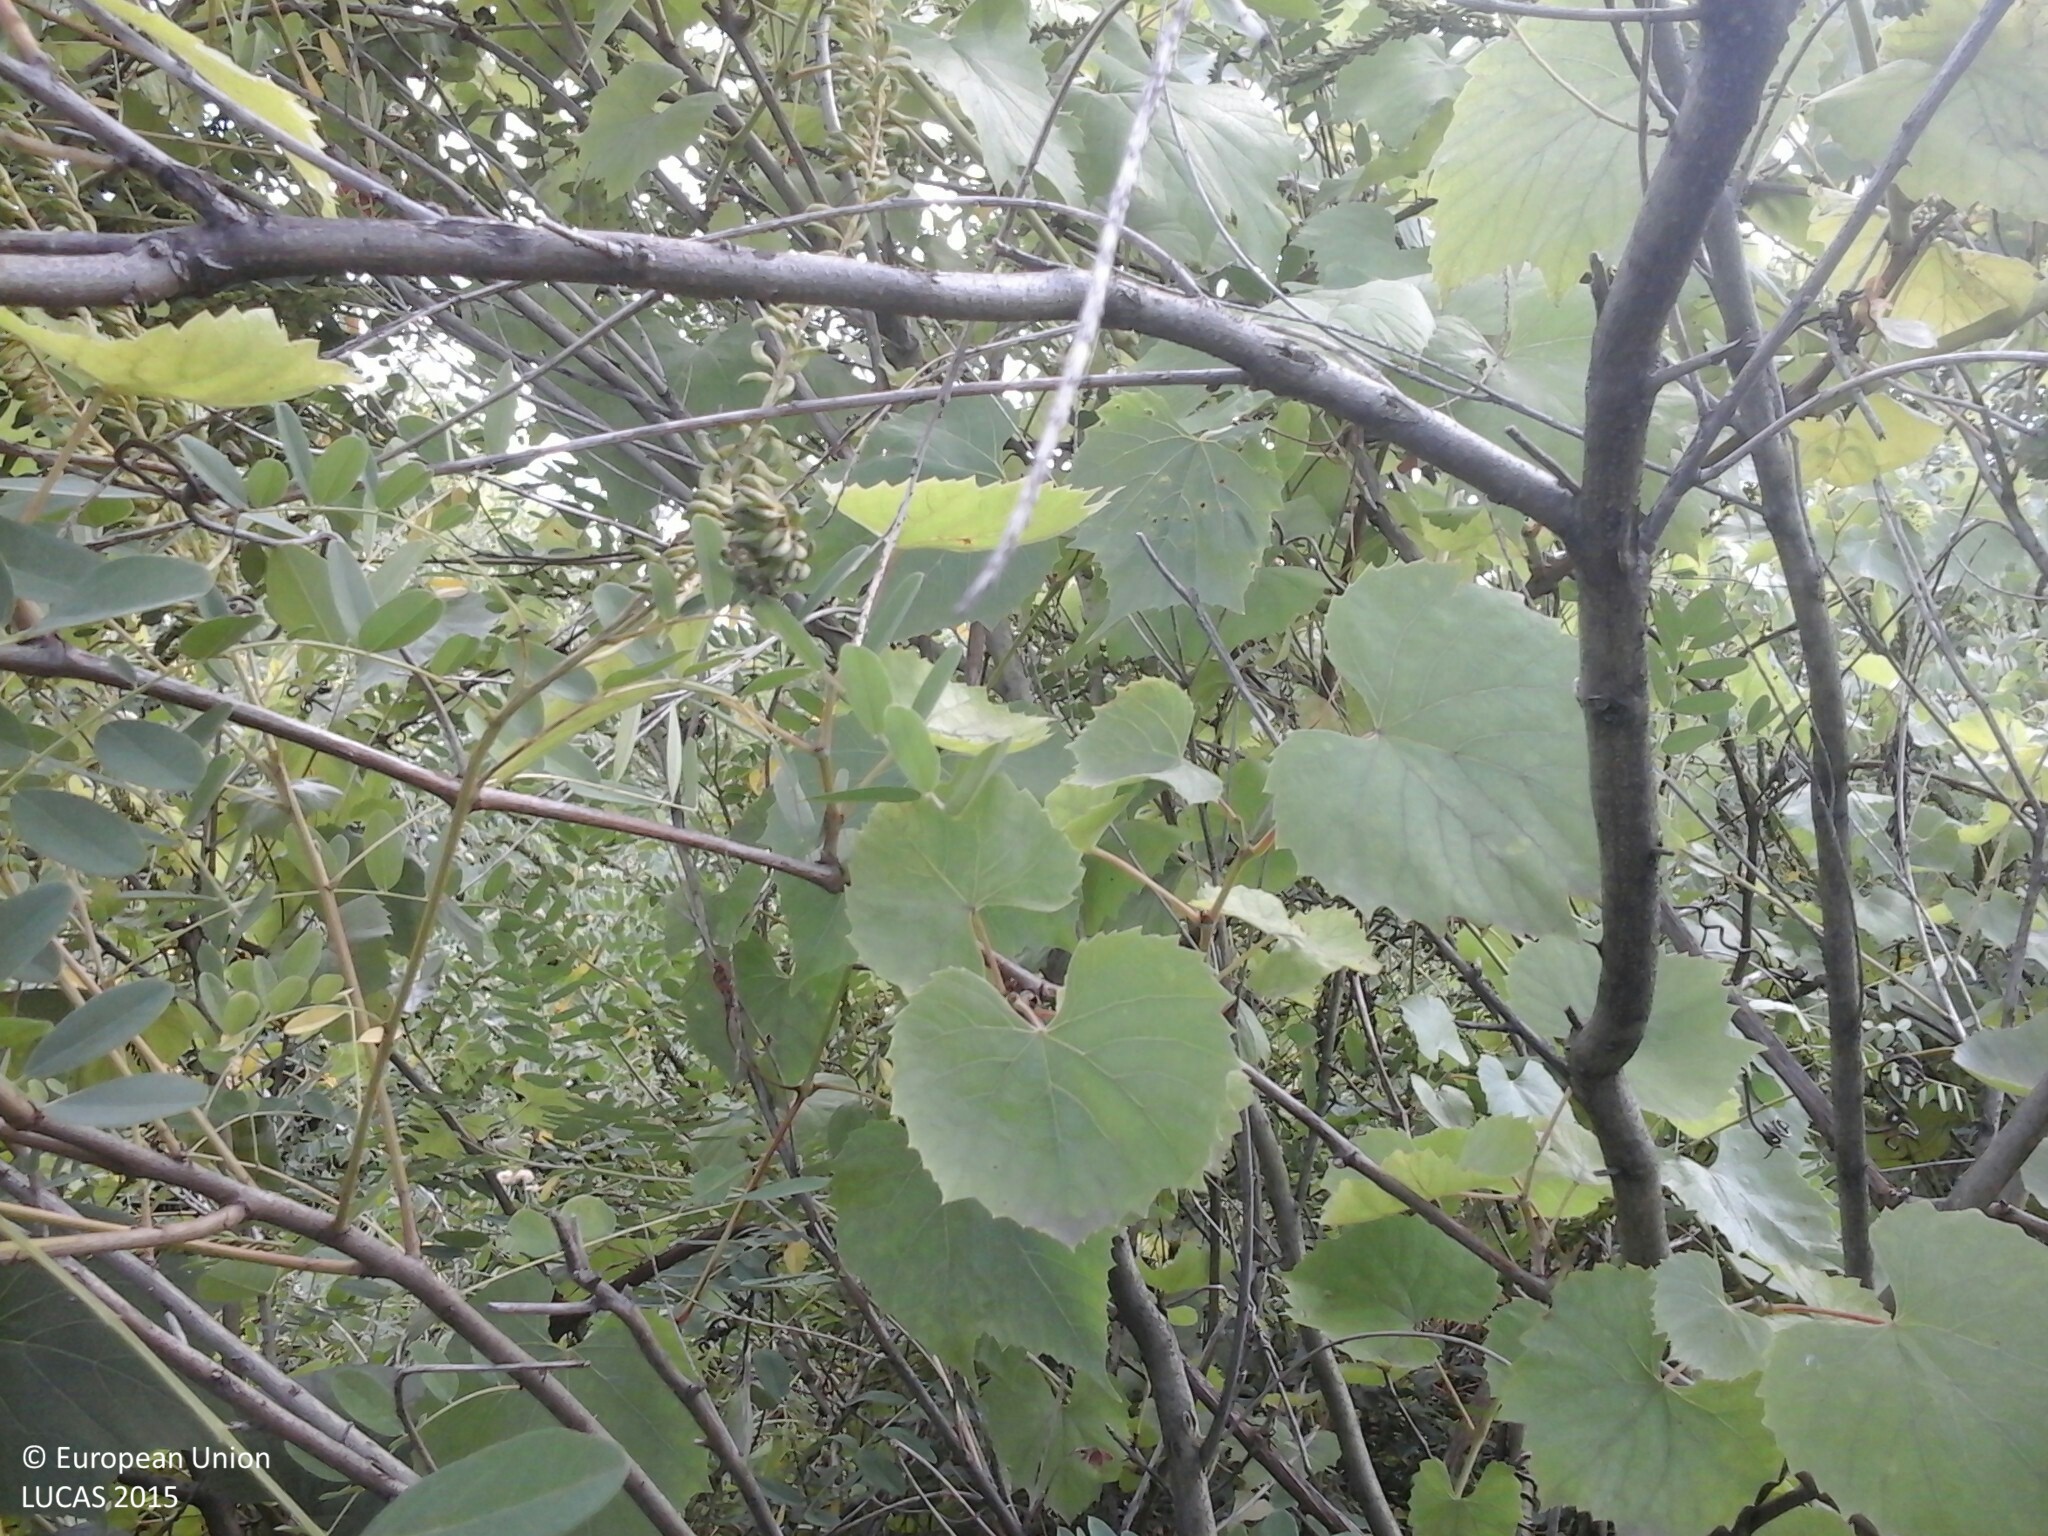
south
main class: Cropland
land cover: Vineyards
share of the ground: 25 - 50 %
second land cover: Spontaneously vegetated surfaces
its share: 25 - 50 %
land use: Agriculture (excluding fallow land and kitchen gardens)
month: July
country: HU
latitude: 47.8404
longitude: 20.3865
